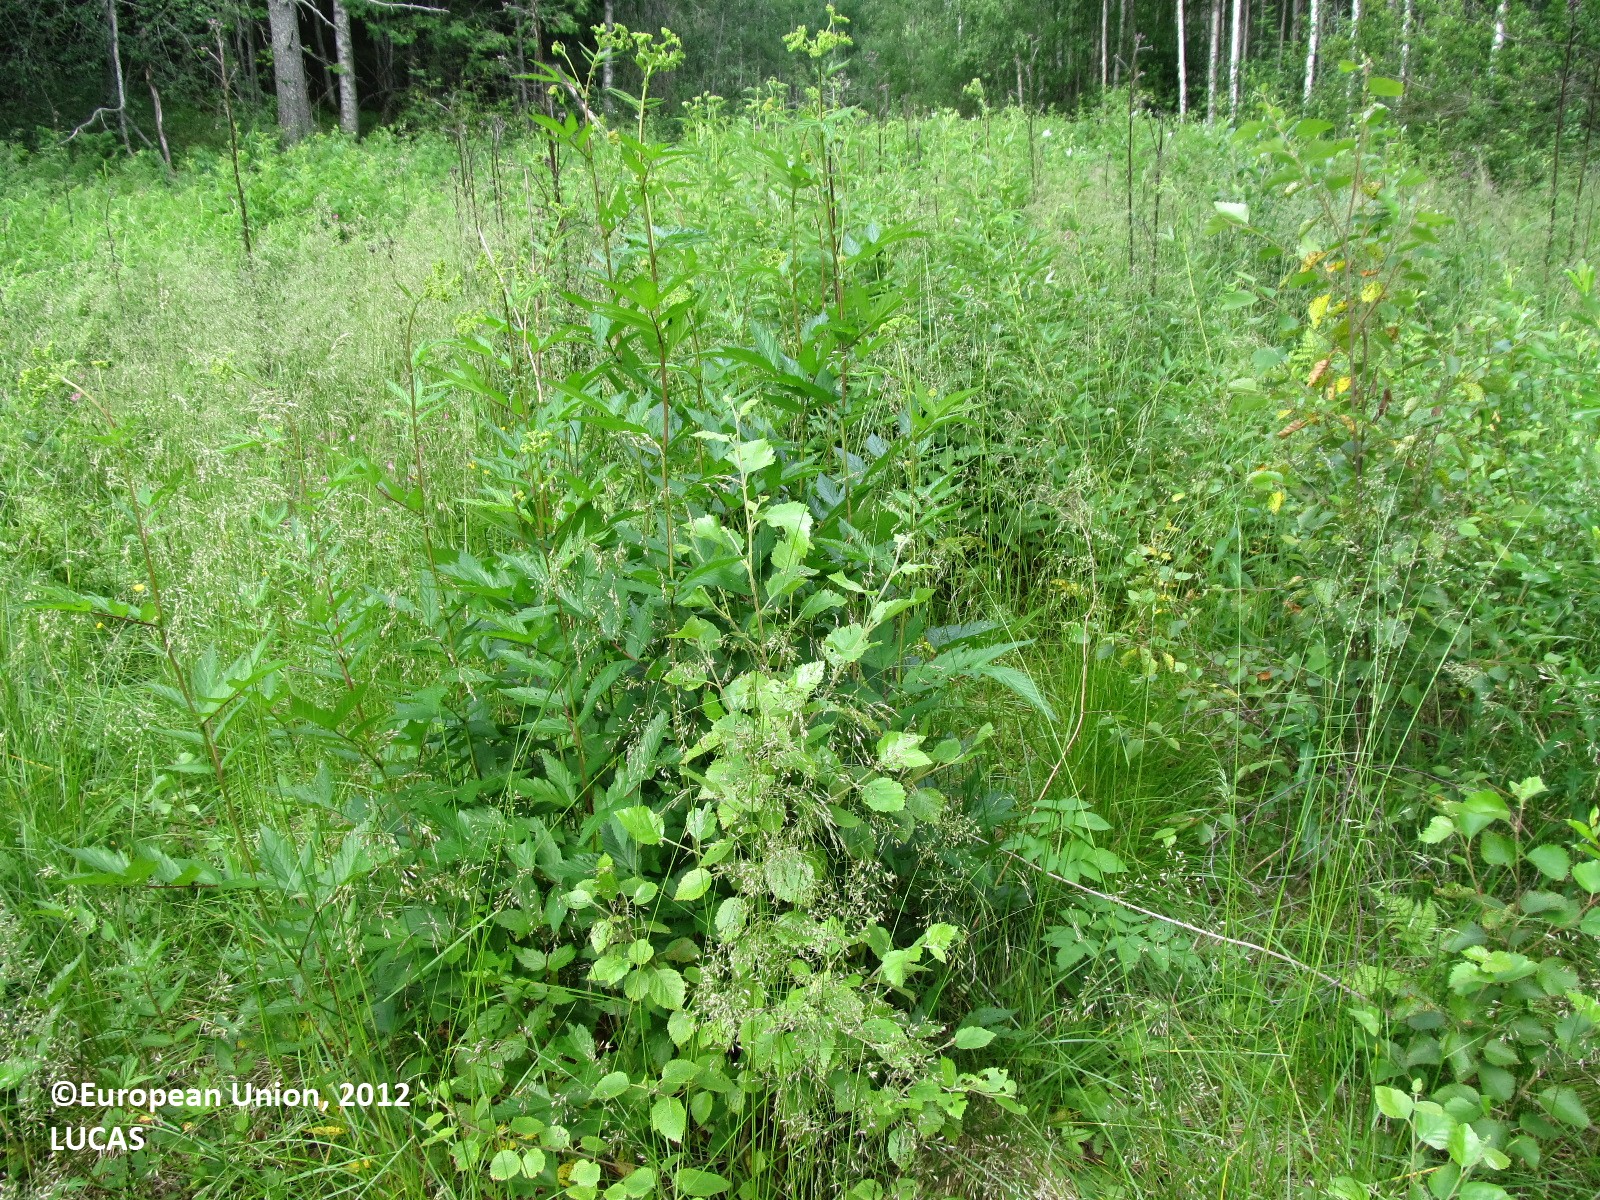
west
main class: Grassland
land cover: Grassland with sparse tree/shrub cover
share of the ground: > 75 %
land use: Semi-natural and natural areas not in use
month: July
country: FI
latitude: 61.8720
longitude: 29.1121
